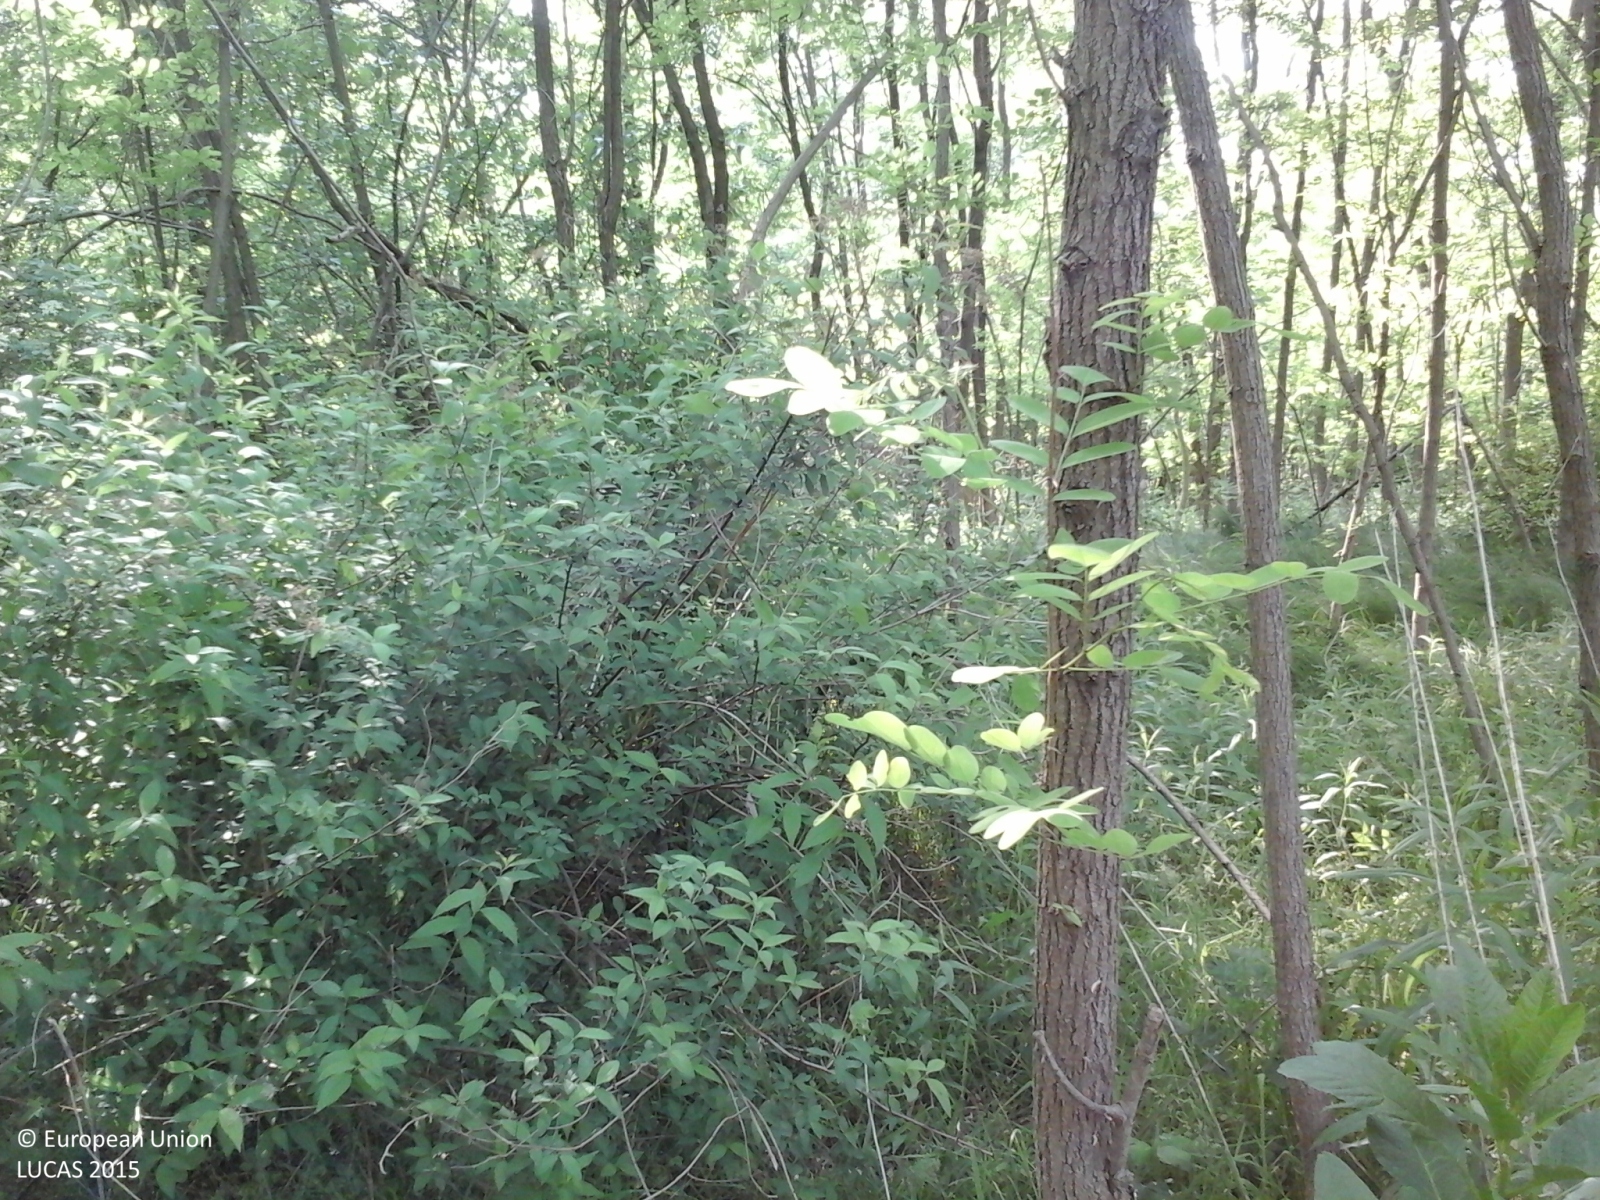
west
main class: Woodland
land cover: Broadleaved woodland
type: mesophytic deciduous forest
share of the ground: > 75 %
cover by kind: broadleaved forest trees 100 %
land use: Forestry
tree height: > 5 m
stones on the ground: < 10 %
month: May
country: IT
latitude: 45.5820
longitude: 8.3749
